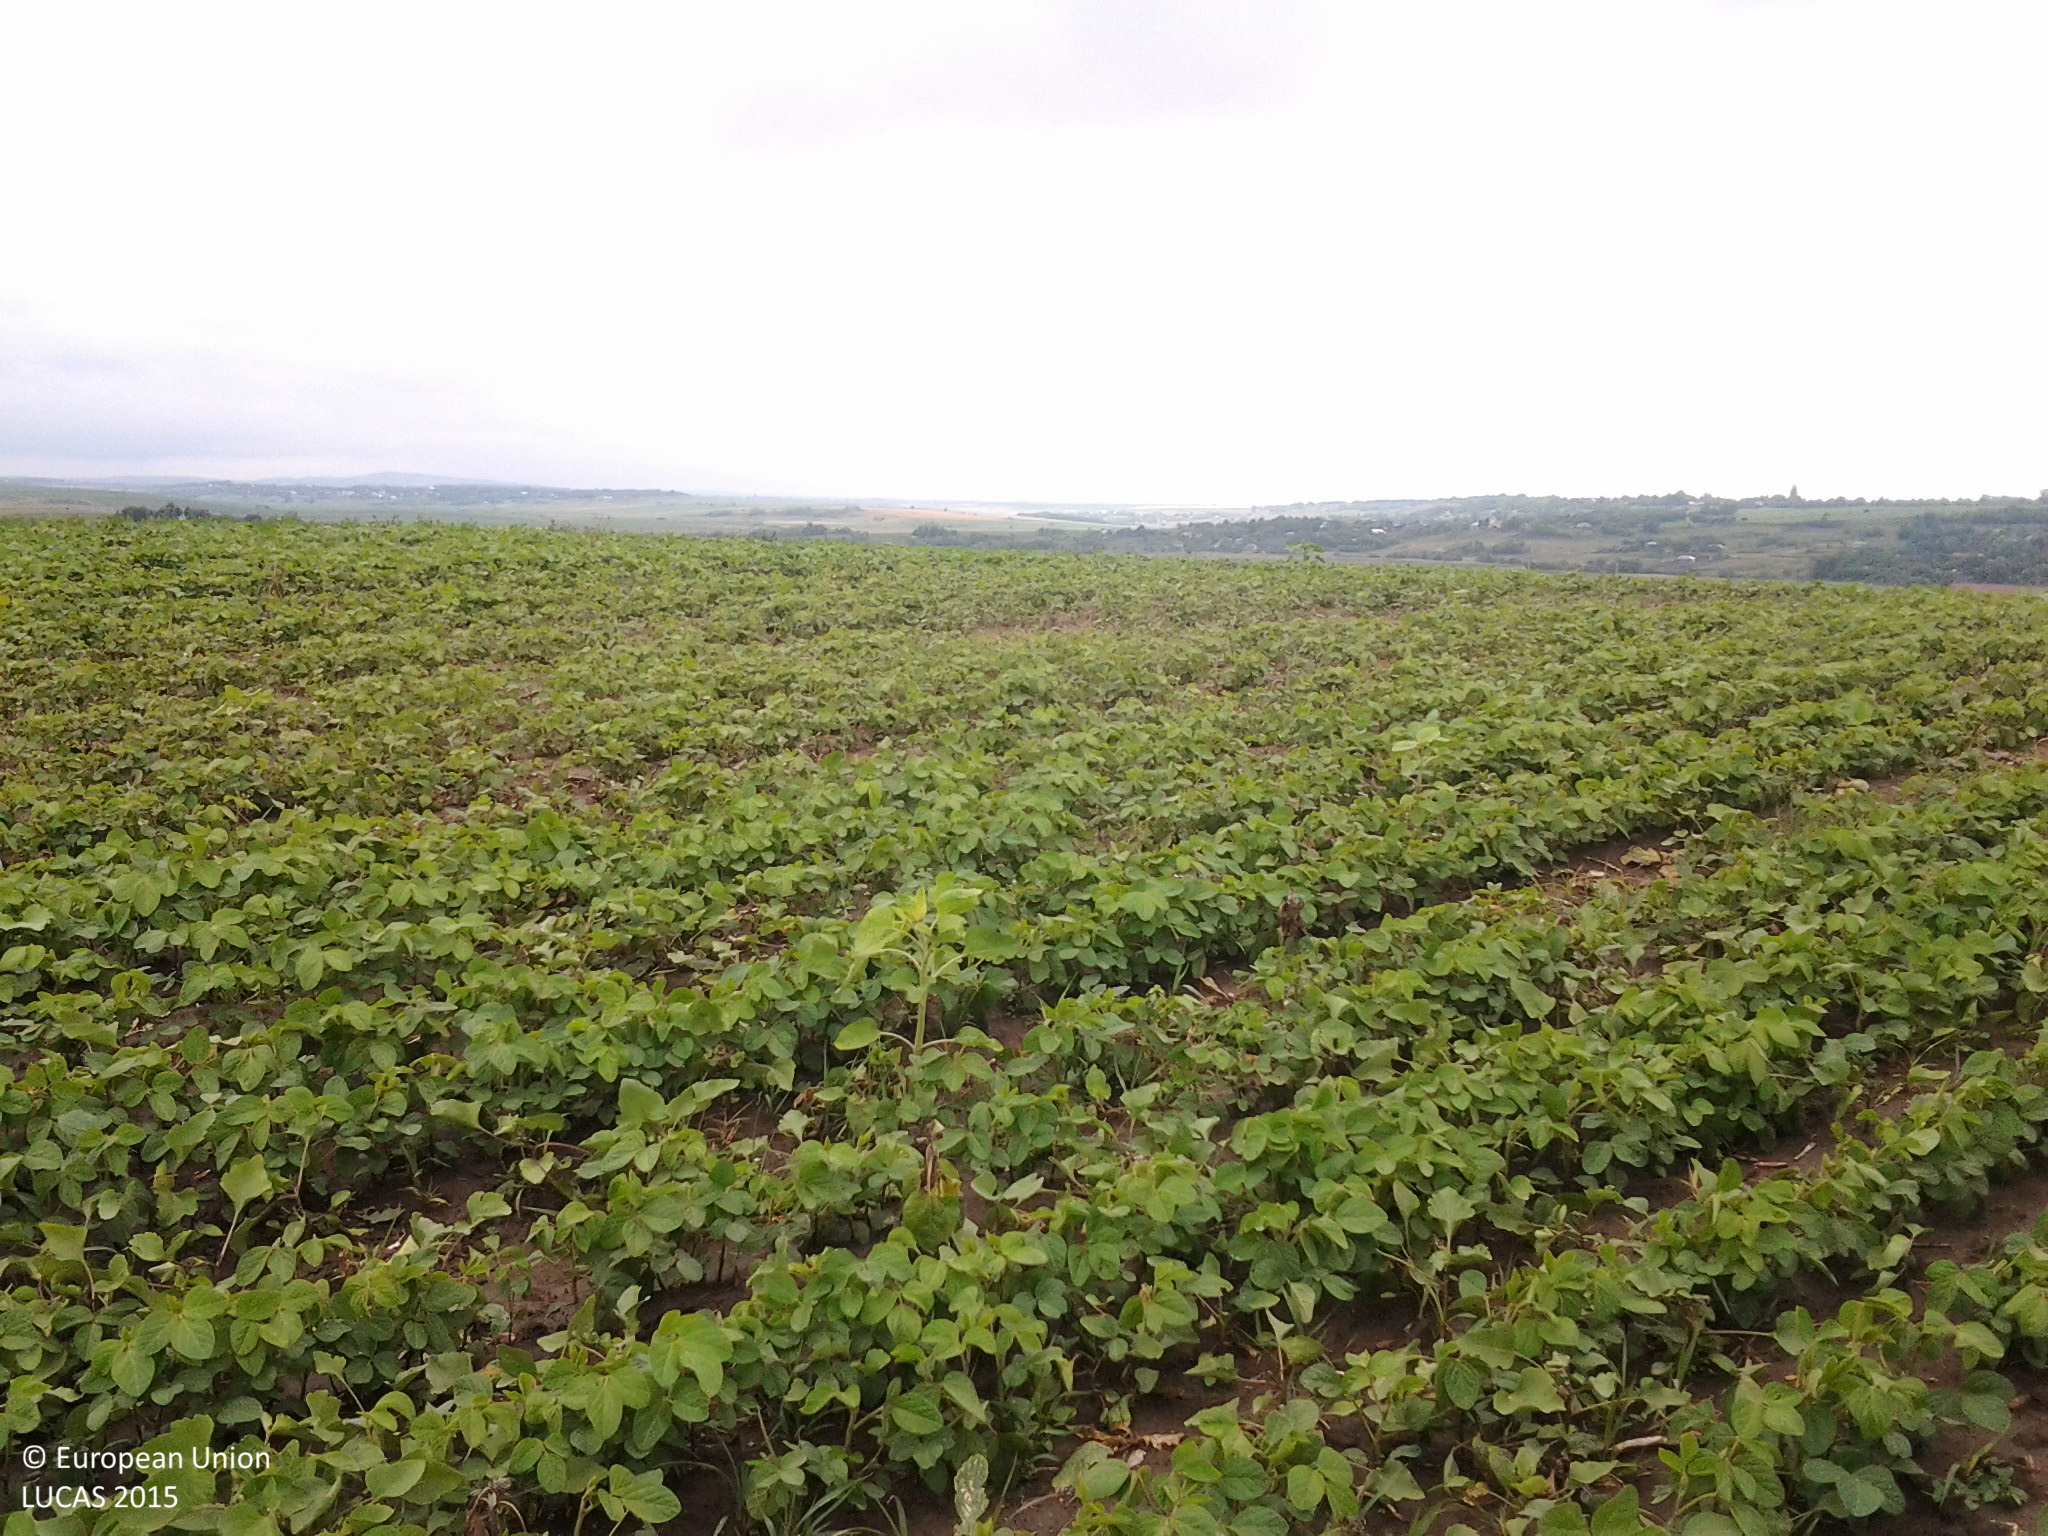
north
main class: Cropland
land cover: Soya
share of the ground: 50 - 75 %
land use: Agriculture (excluding fallow land and kitchen gardens)
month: June
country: RO
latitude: 47.9218
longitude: 26.5122
